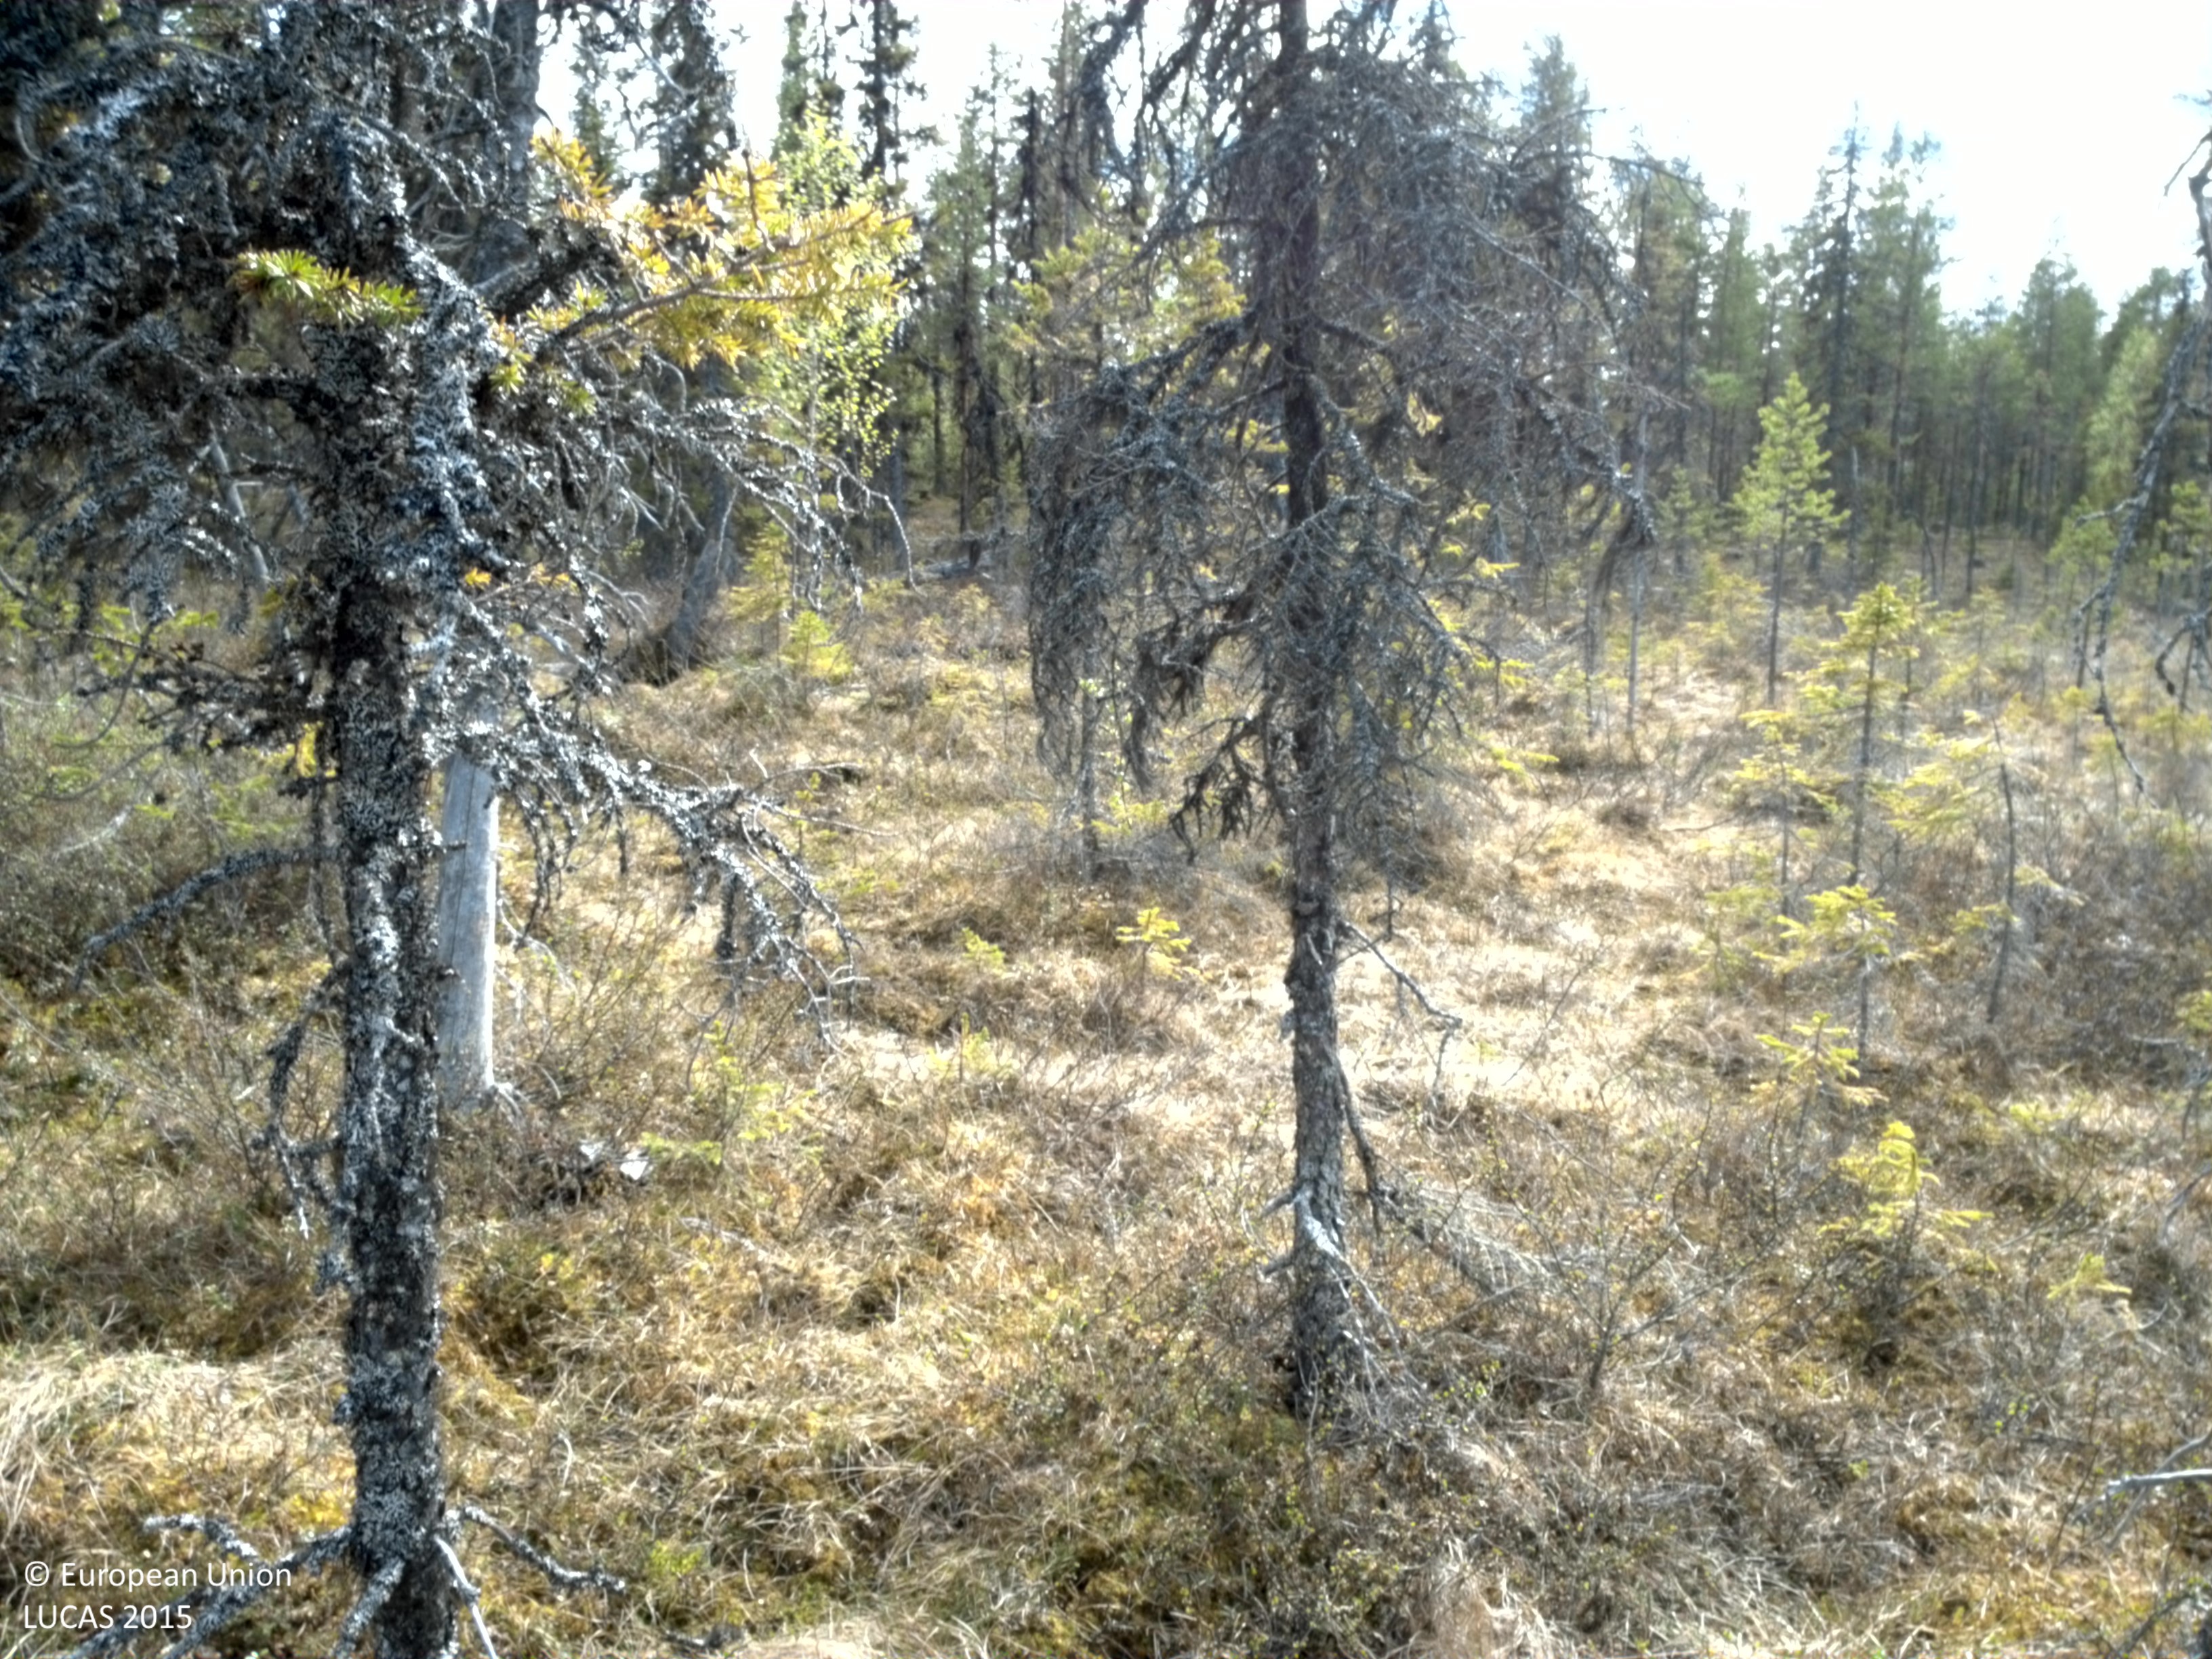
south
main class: Woodland
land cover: Spruce dominated coniferous woodland
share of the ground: 10 - 25 %
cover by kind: shrubs 60 %, herbaceous plants 20 %, coniferous forest trees 15 %, lichens and mosses 5 %
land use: Semi-natural and natural areas not in use
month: June
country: SE
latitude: 66.1741
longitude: 18.8060
